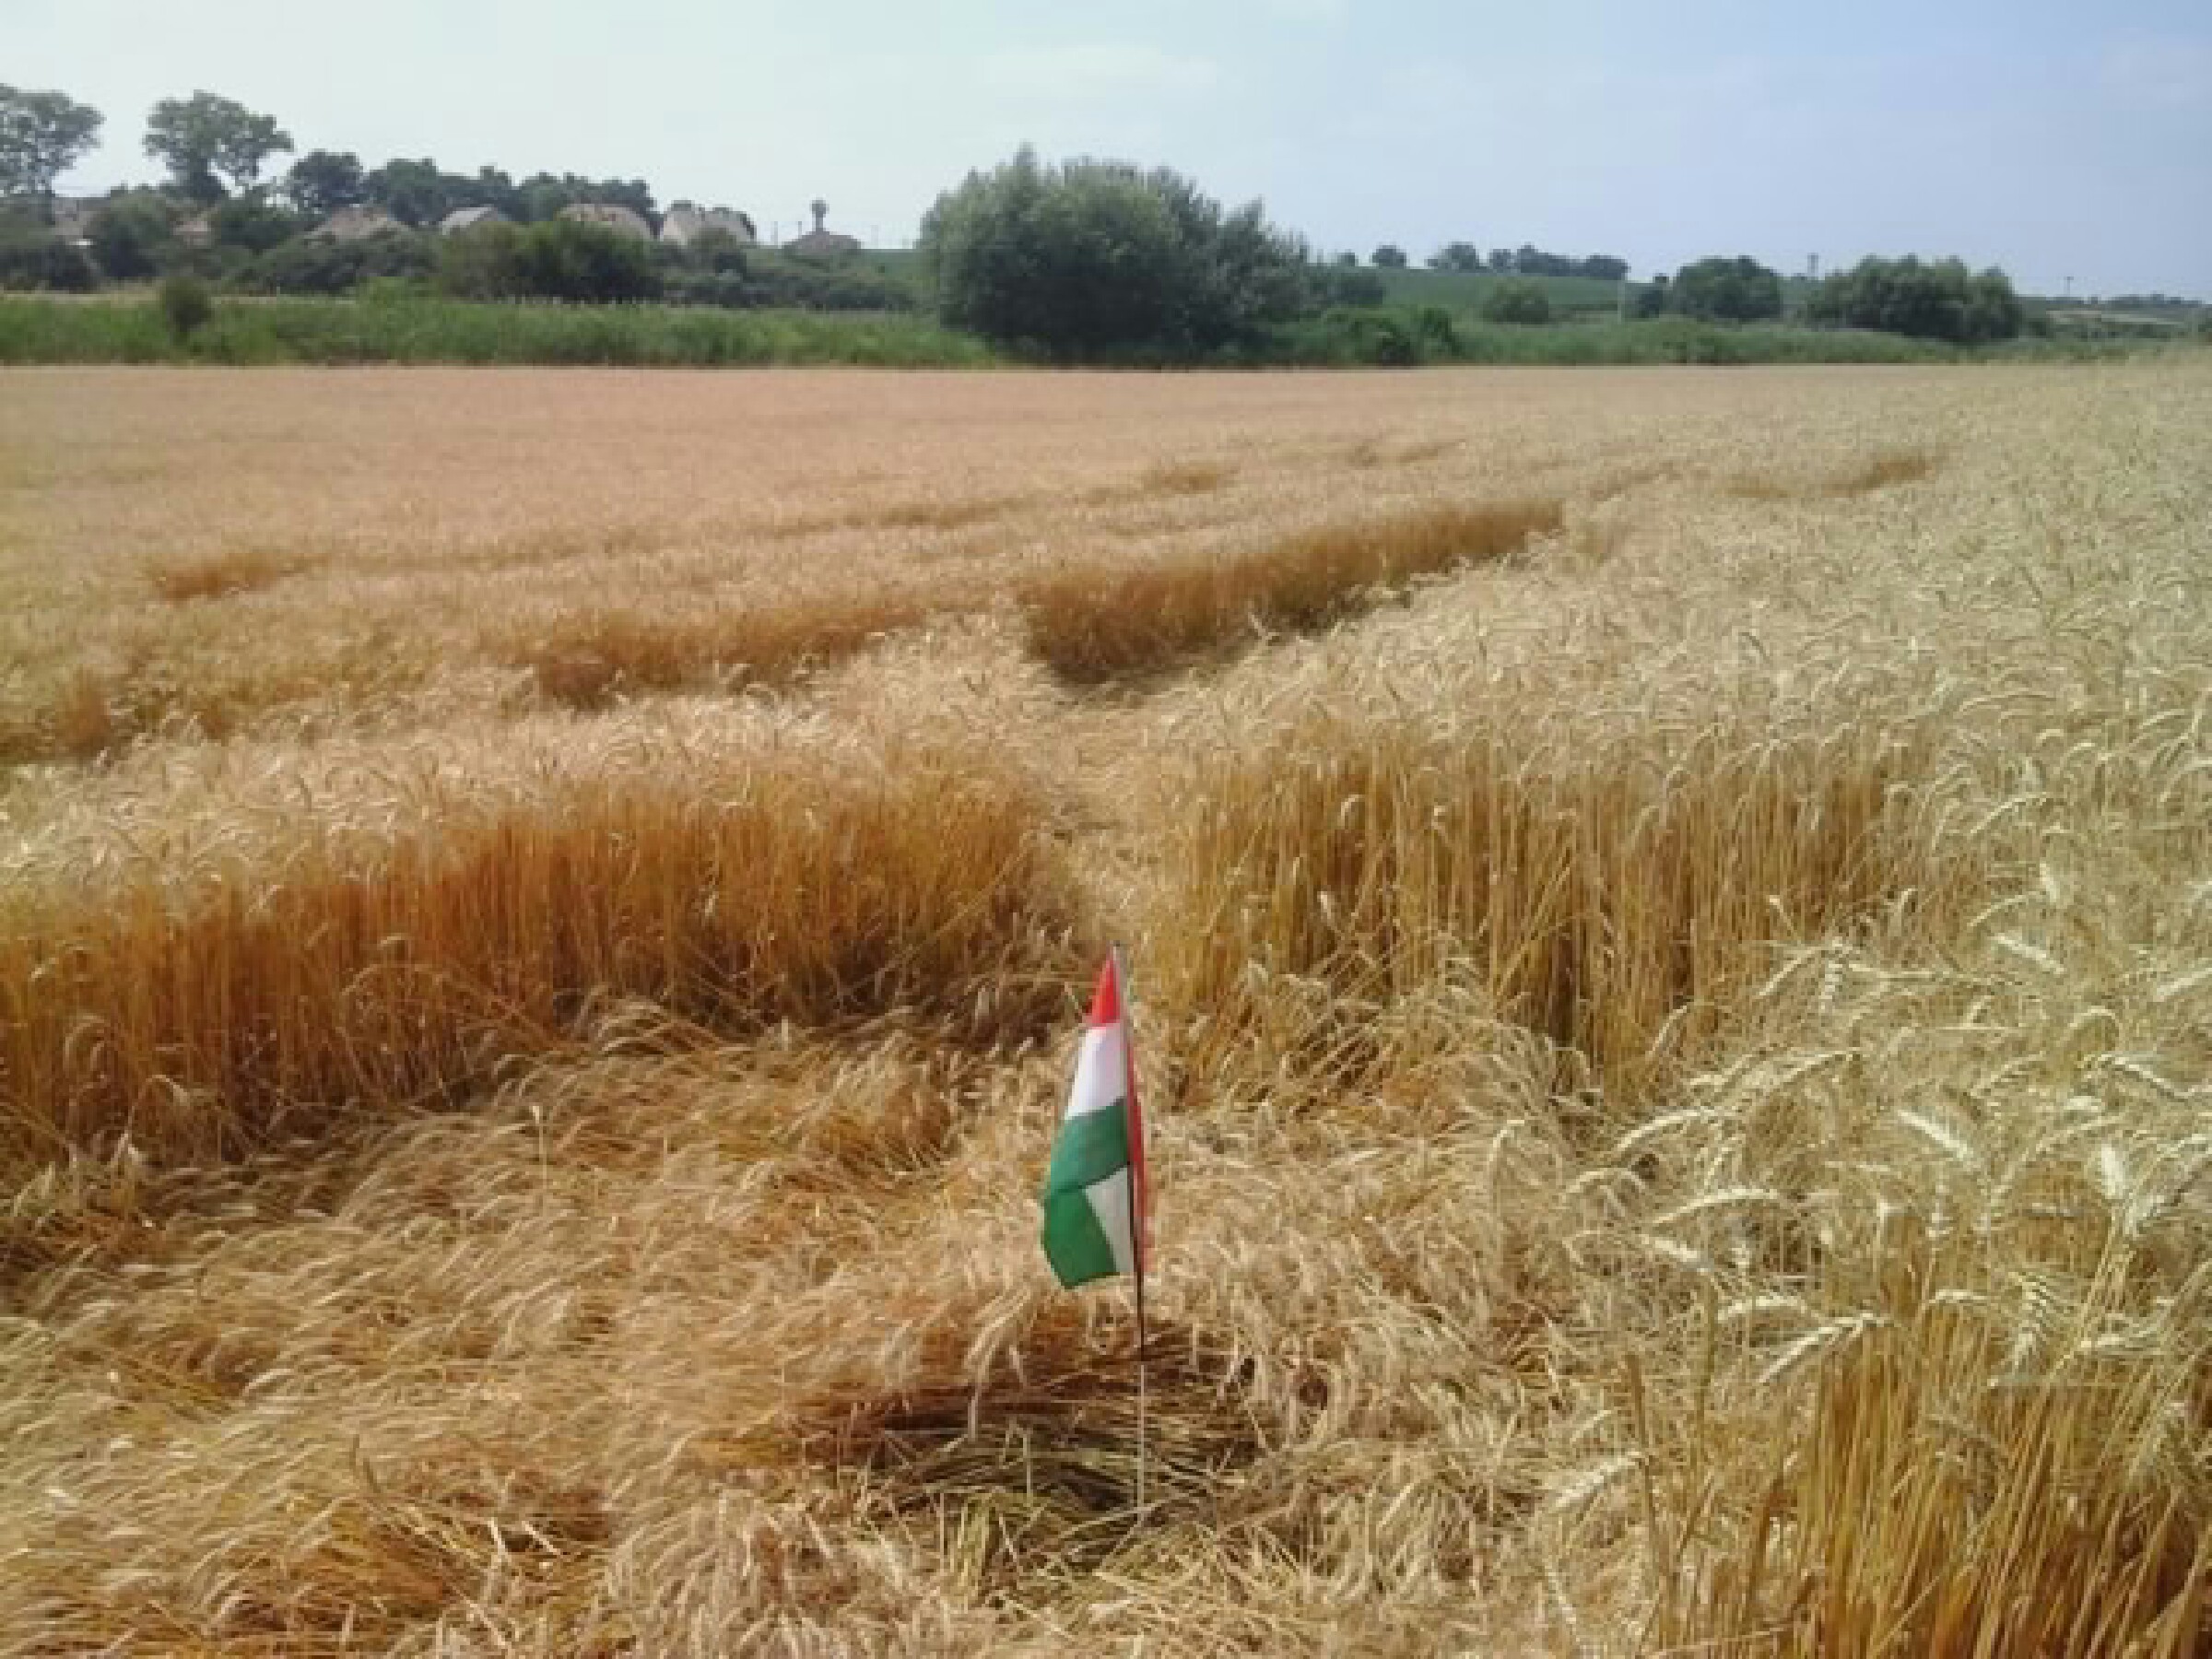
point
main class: Cropland
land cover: Common wheat
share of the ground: > 75 %
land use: Agriculture (excluding fallow land and kitchen gardens)
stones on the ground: < 10 %
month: July
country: HU
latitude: 47.8581
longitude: 19.3915
